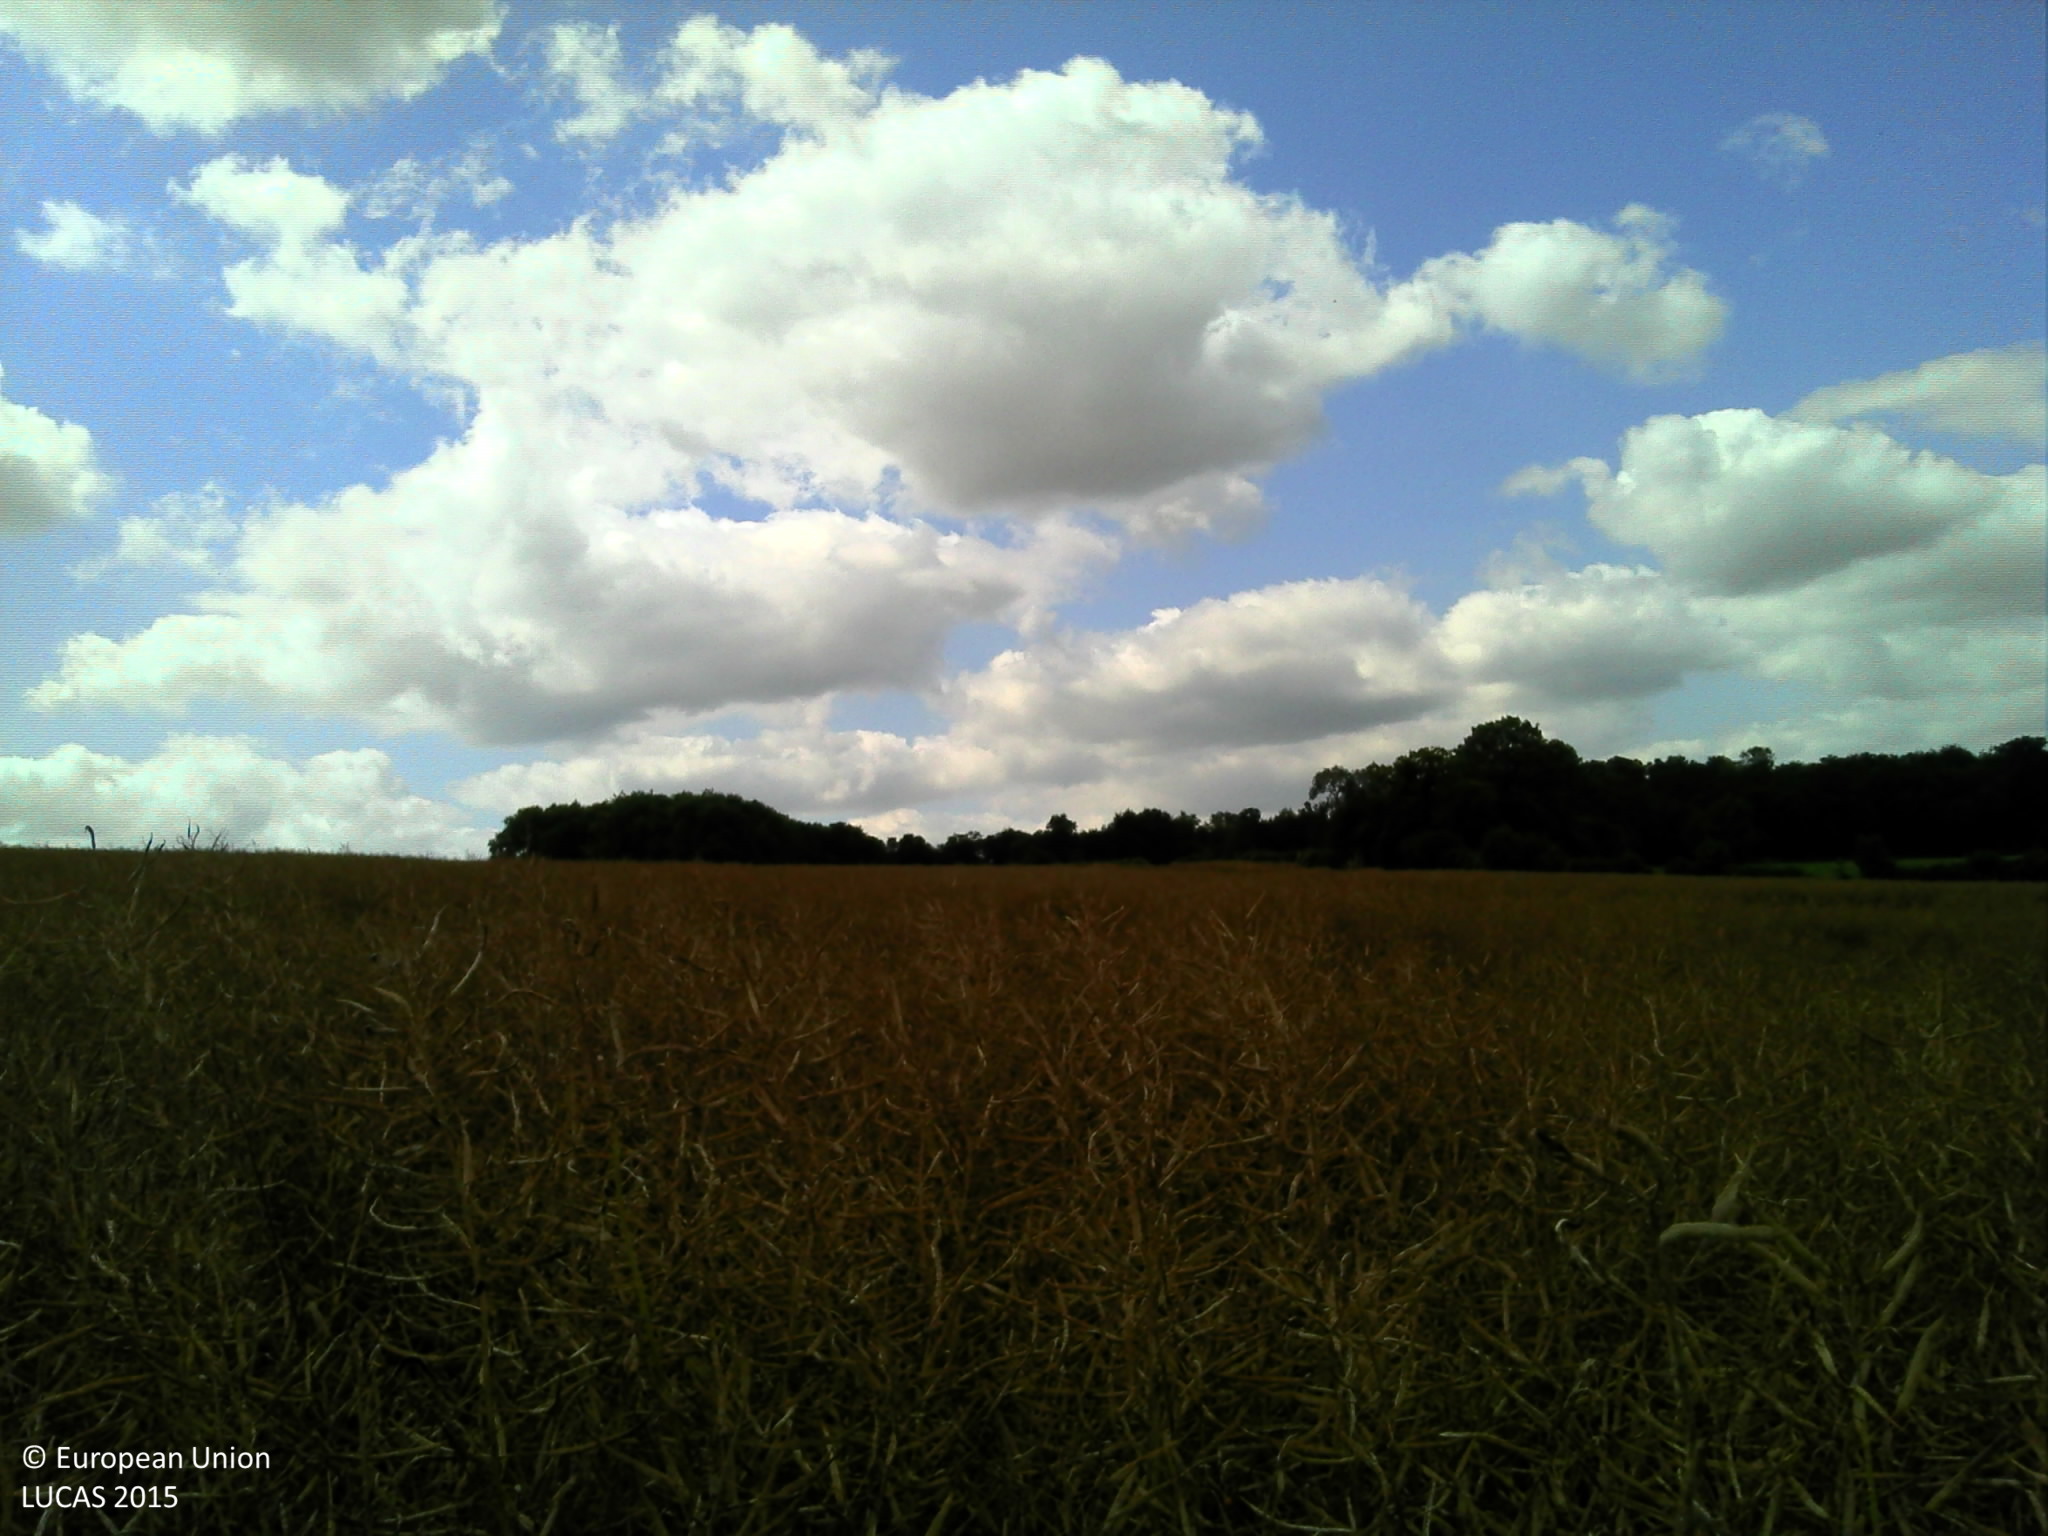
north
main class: Cropland
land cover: Rape and turnip rape
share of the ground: > 75 %
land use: Agriculture (excluding fallow land and kitchen gardens)
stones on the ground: < 10 %
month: July
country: FR
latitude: 48.9812
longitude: -0.2123
